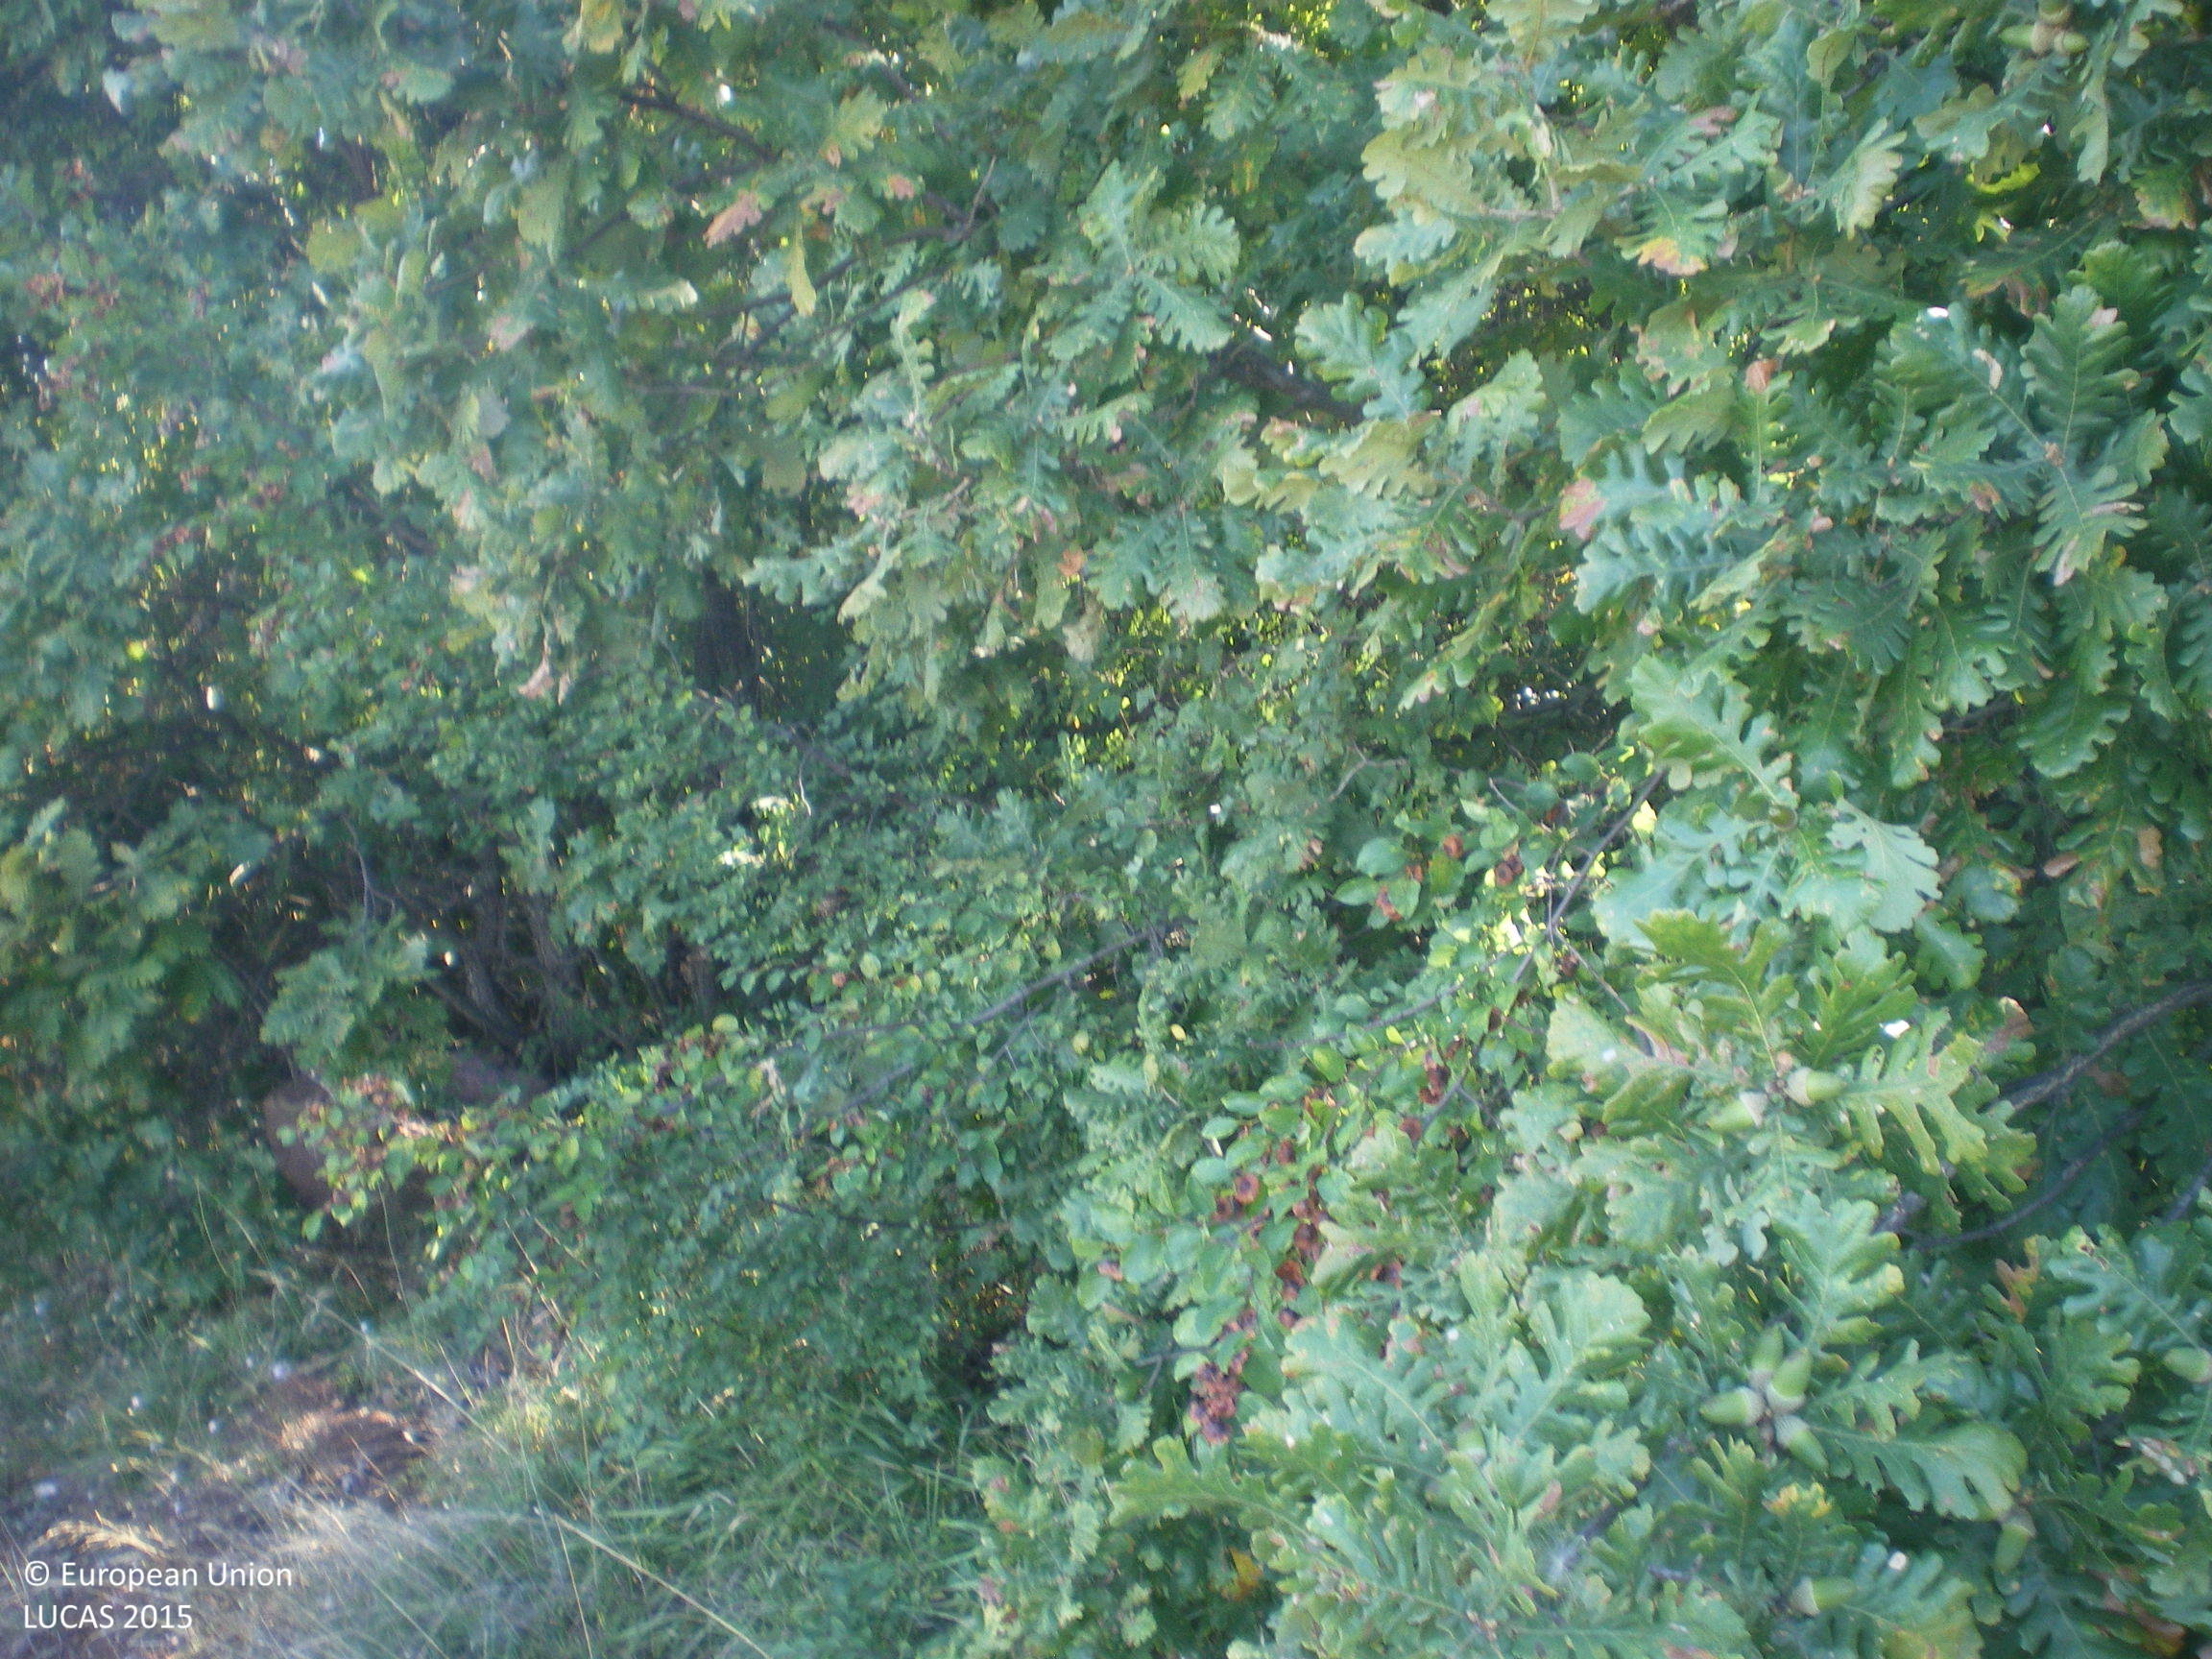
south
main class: Cropland
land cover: Common wheat
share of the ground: < 10 %
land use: Agriculture (excluding fallow land and kitchen gardens)
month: September
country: BG
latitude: 41.8138
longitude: 25.9979
